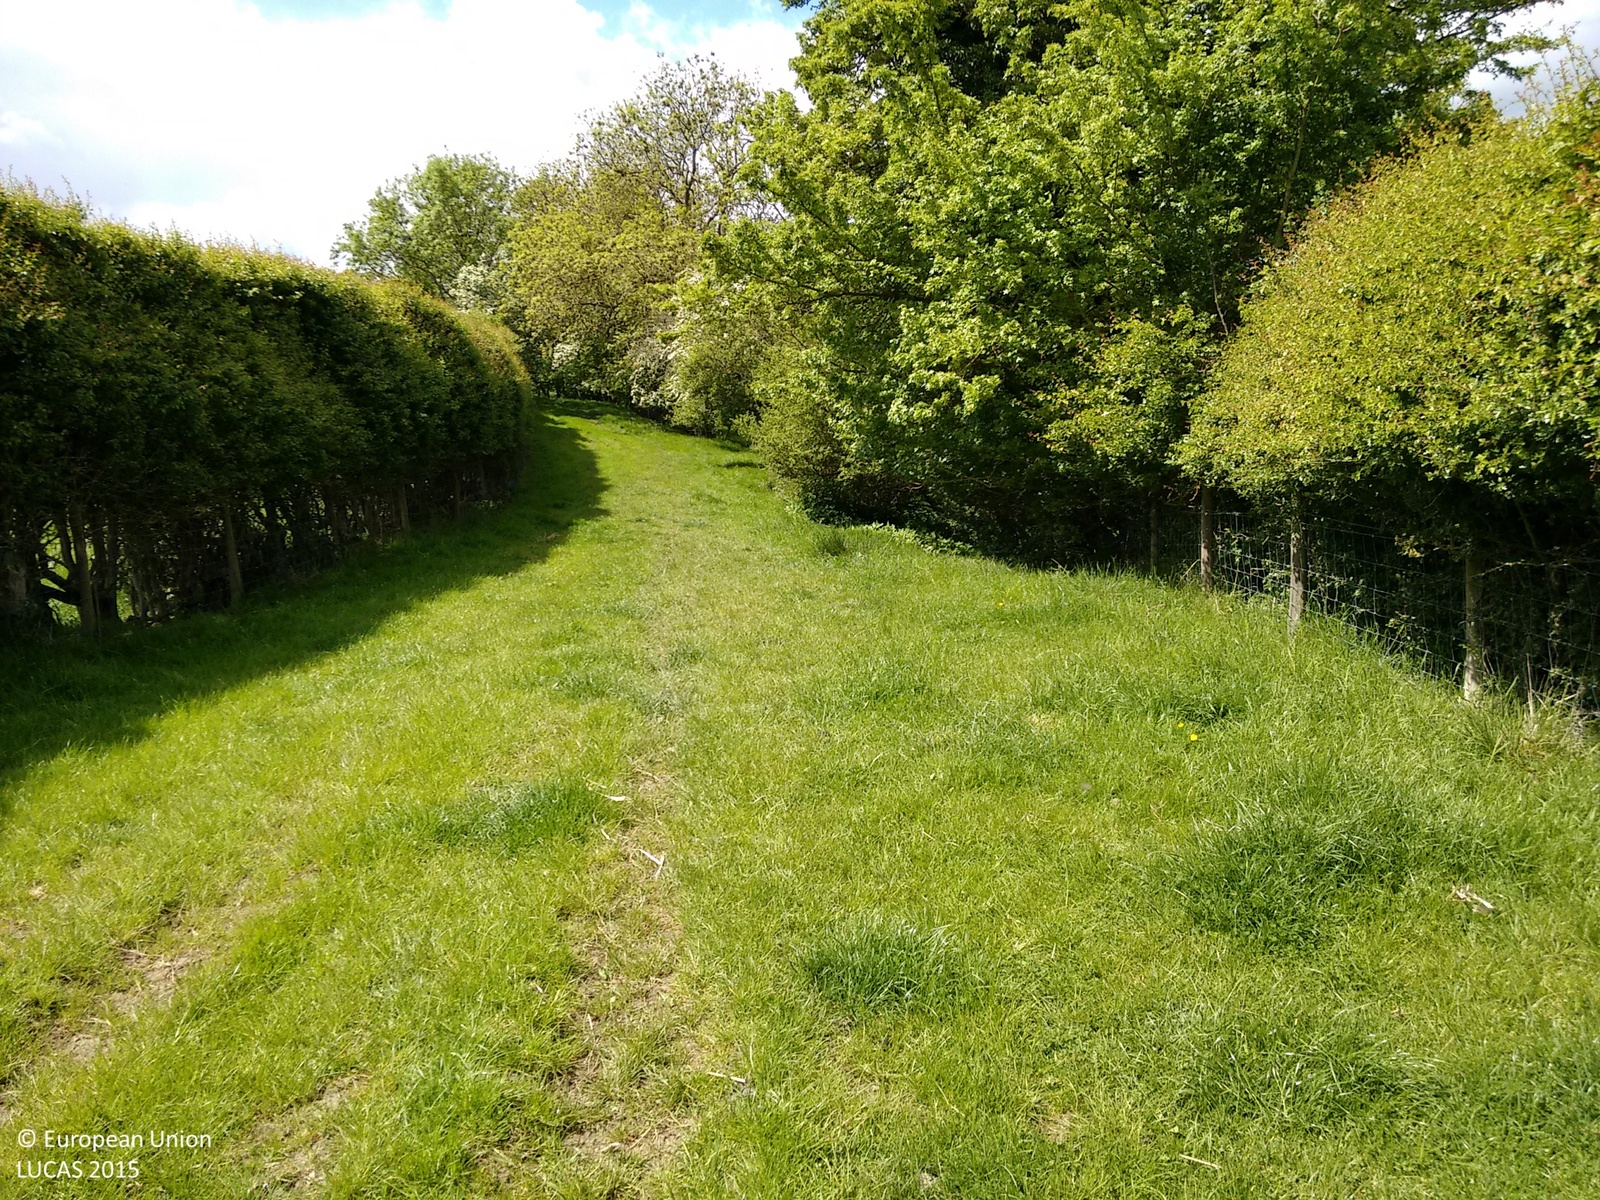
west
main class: Grassland
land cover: Grassland without tree/shrub cover
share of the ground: > 75 %
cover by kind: herbaceous plants 100 %
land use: Agriculture (excluding fallow land and kitchen gardens)
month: May
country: GB
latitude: 54.0037
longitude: -1.2290
